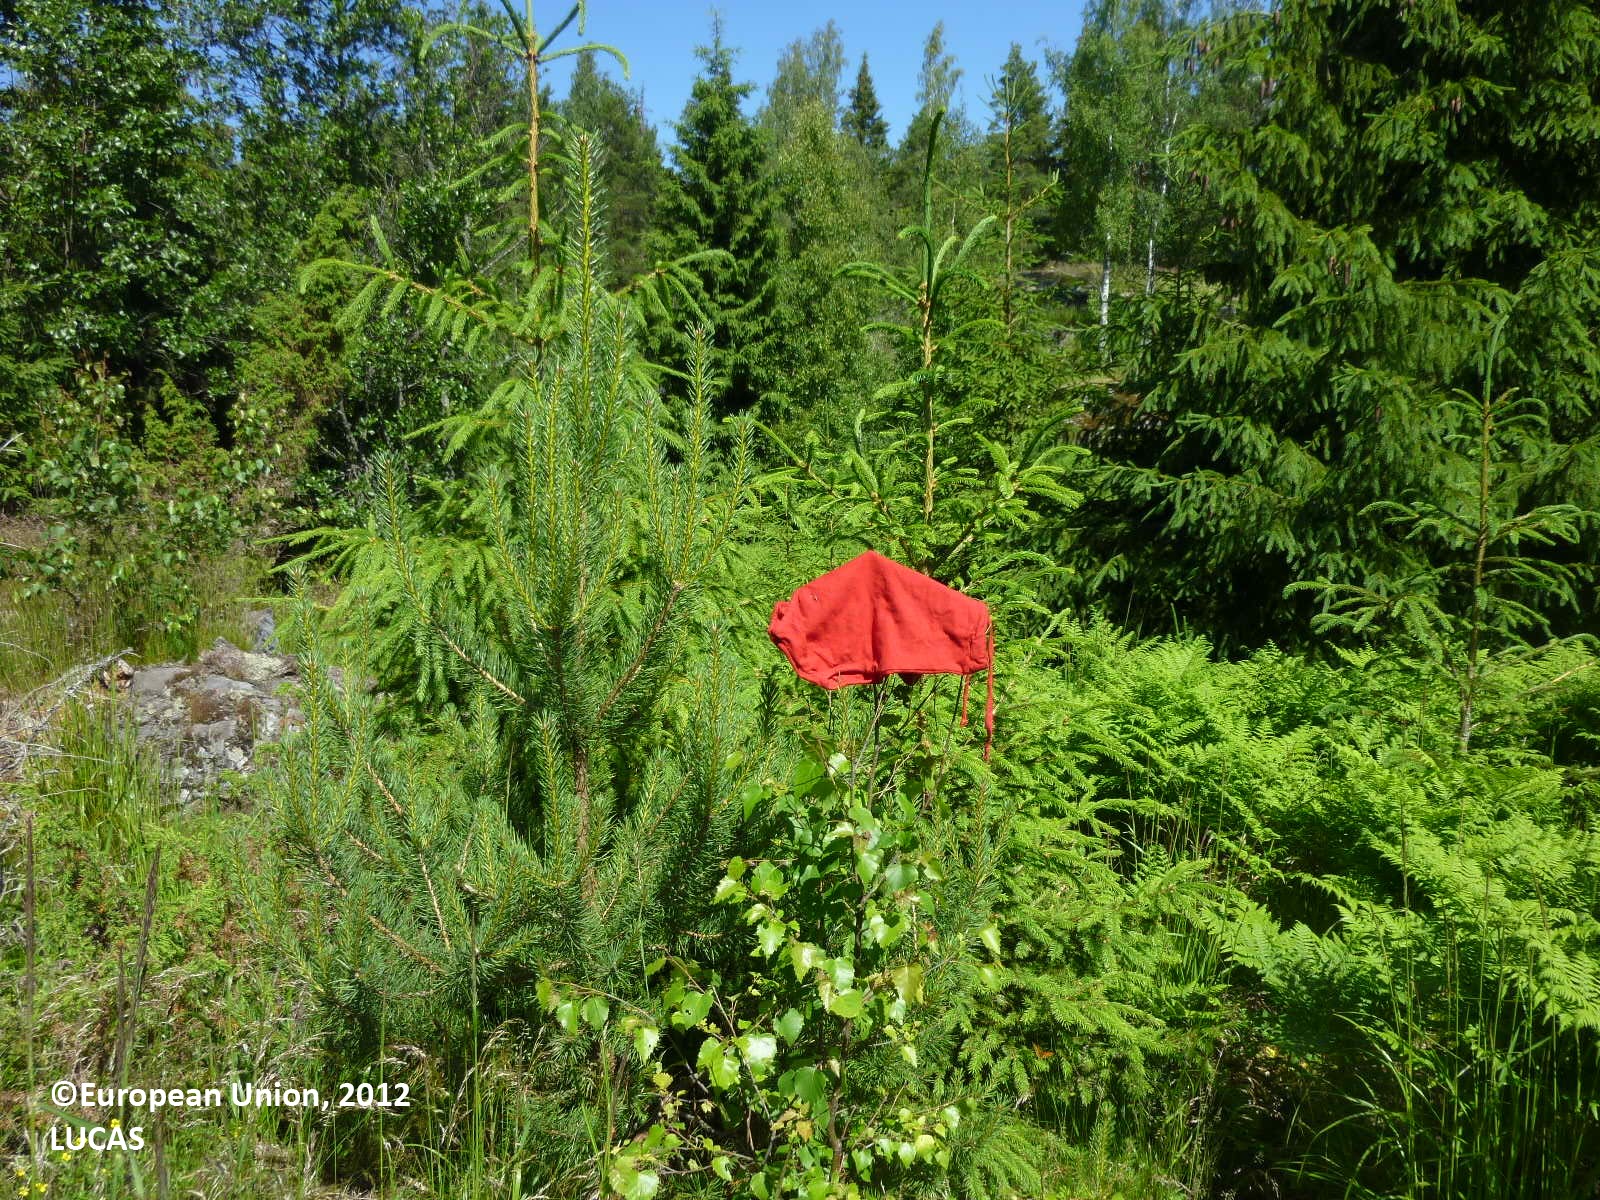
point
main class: Woodland
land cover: Spruce dominated coniferous woodland
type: boreal forest
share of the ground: < 10 %
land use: Forestry
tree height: > 5 m
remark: Clear cut
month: June
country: FI
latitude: 60.1434
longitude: 22.5895
